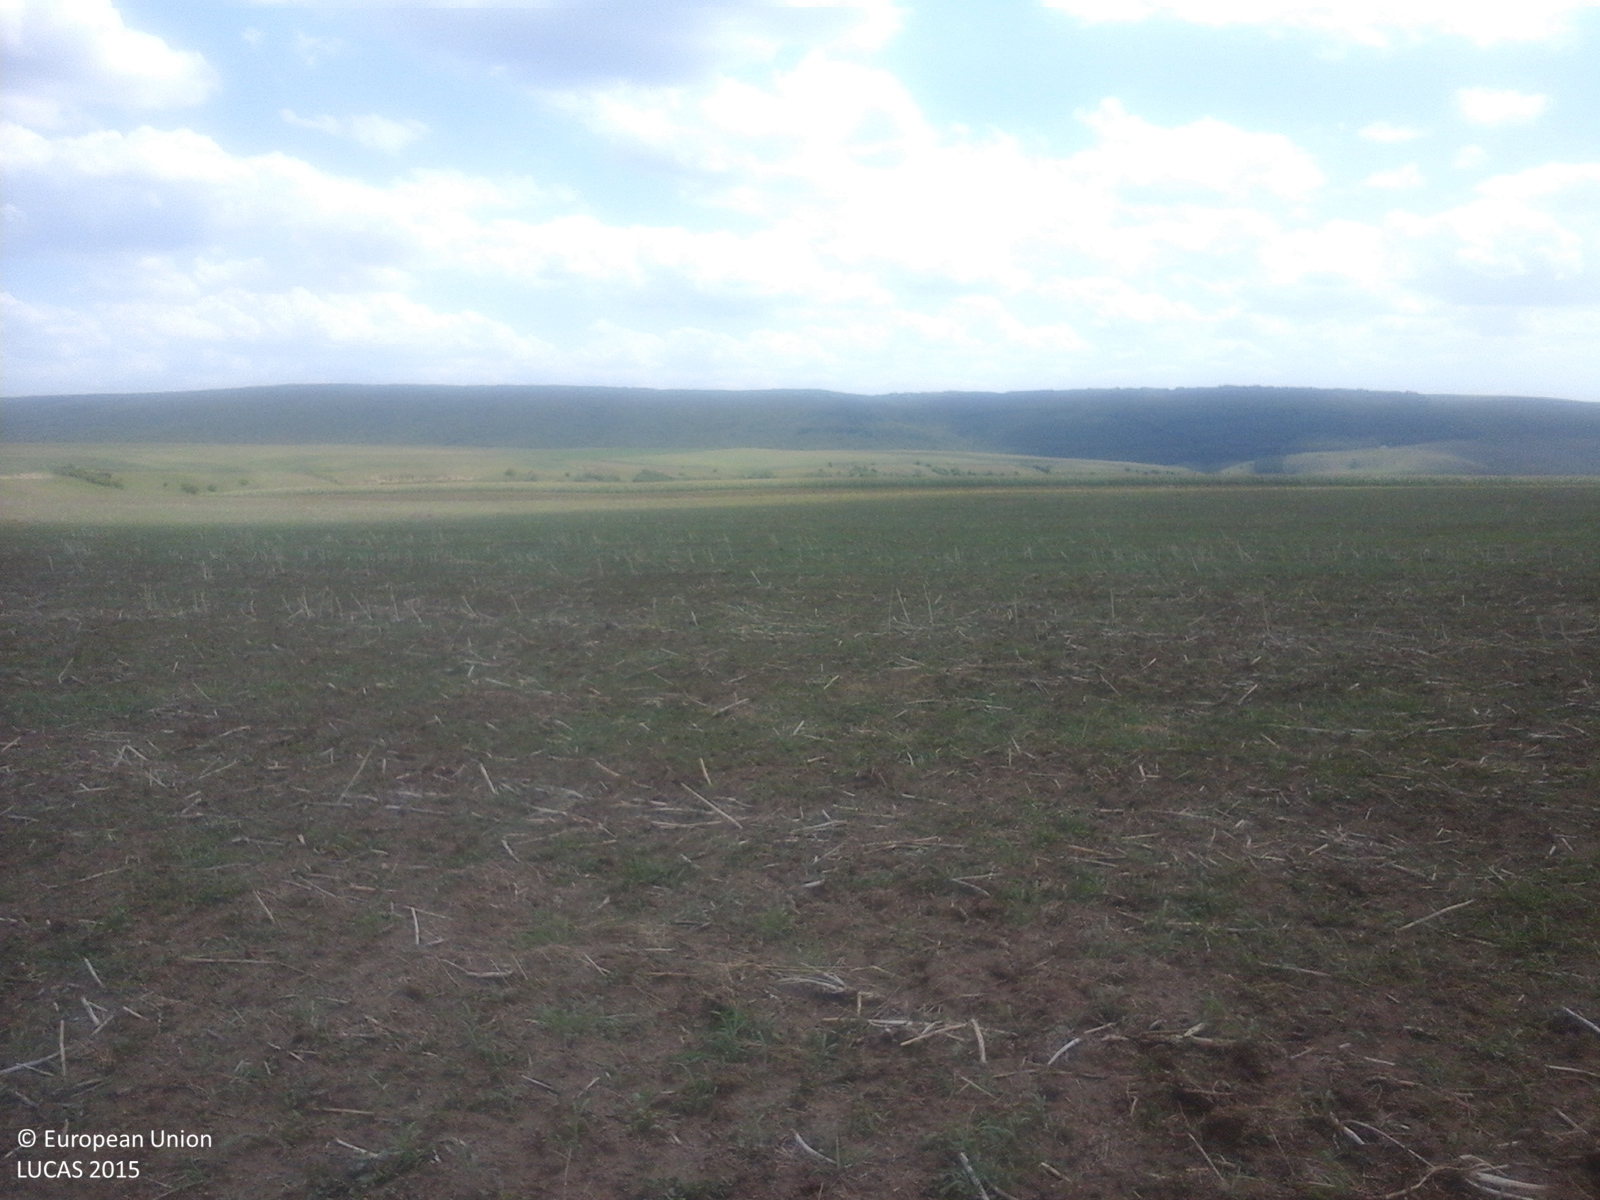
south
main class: Cropland
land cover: Rape and turnip rape
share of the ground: < 10 %
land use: Agriculture (excluding fallow land and kitchen gardens)
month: July
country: RO
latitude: 46.4355
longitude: 27.8607
